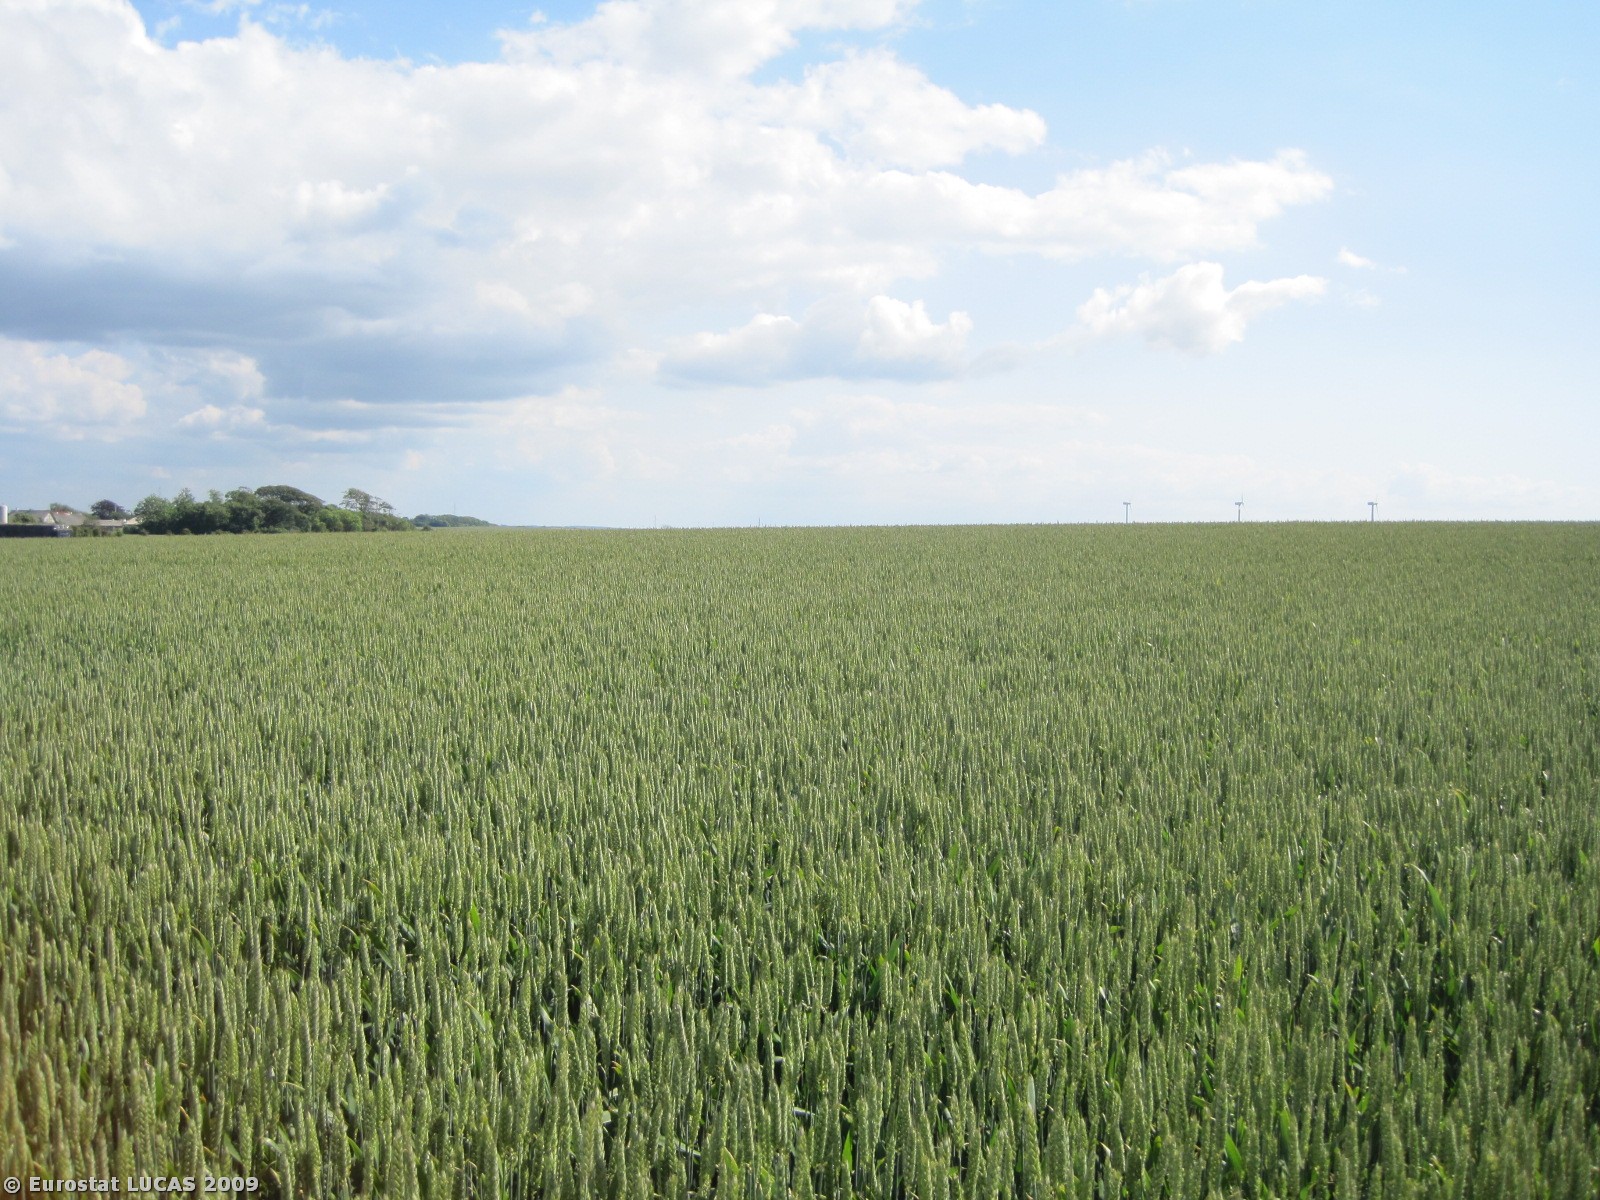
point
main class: Cropland
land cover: Common wheat
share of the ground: > 75 %
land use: Agriculture (excluding fallow land and kitchen gardens)
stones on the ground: < 10 %
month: June
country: DK
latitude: 56.5971
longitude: 8.9753
